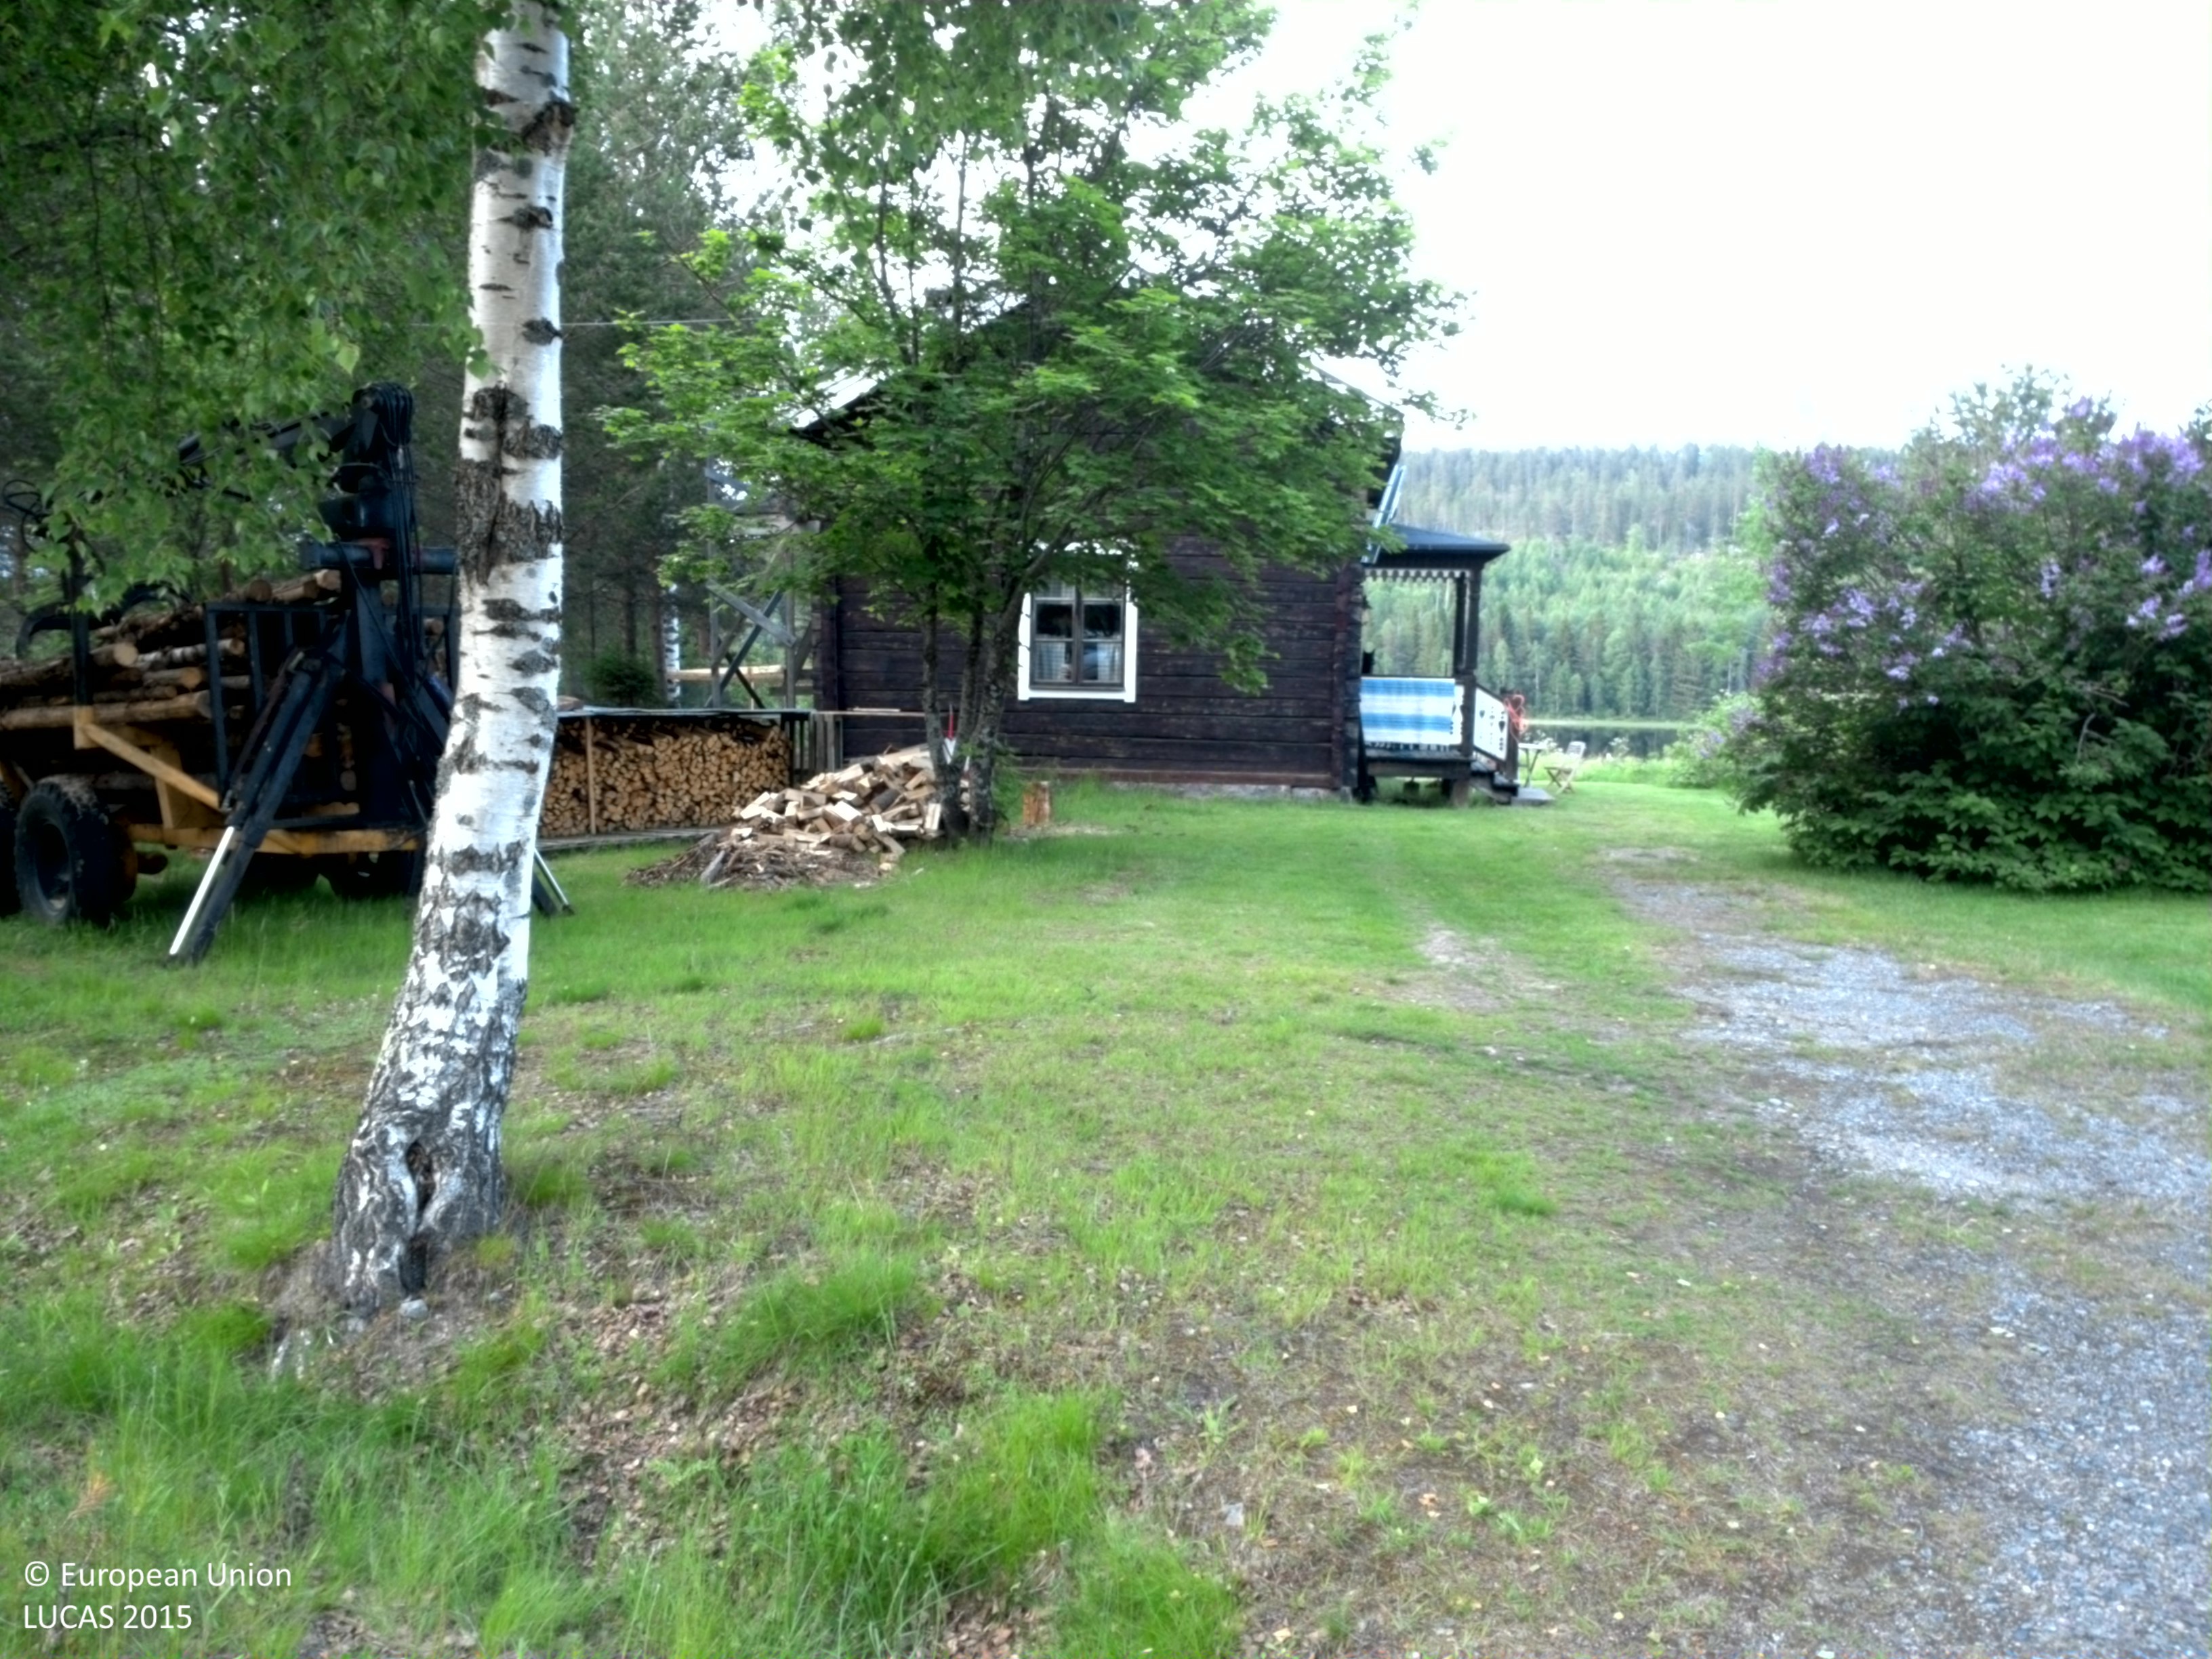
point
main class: Grassland
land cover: Grassland with sparse tree/shrub cover
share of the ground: > 75 %
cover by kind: herbaceous plants 95 %, broadleaved forest trees 5 %
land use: Residential
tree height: > 5 m
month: July
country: SE
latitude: 64.4812
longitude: 20.8606
